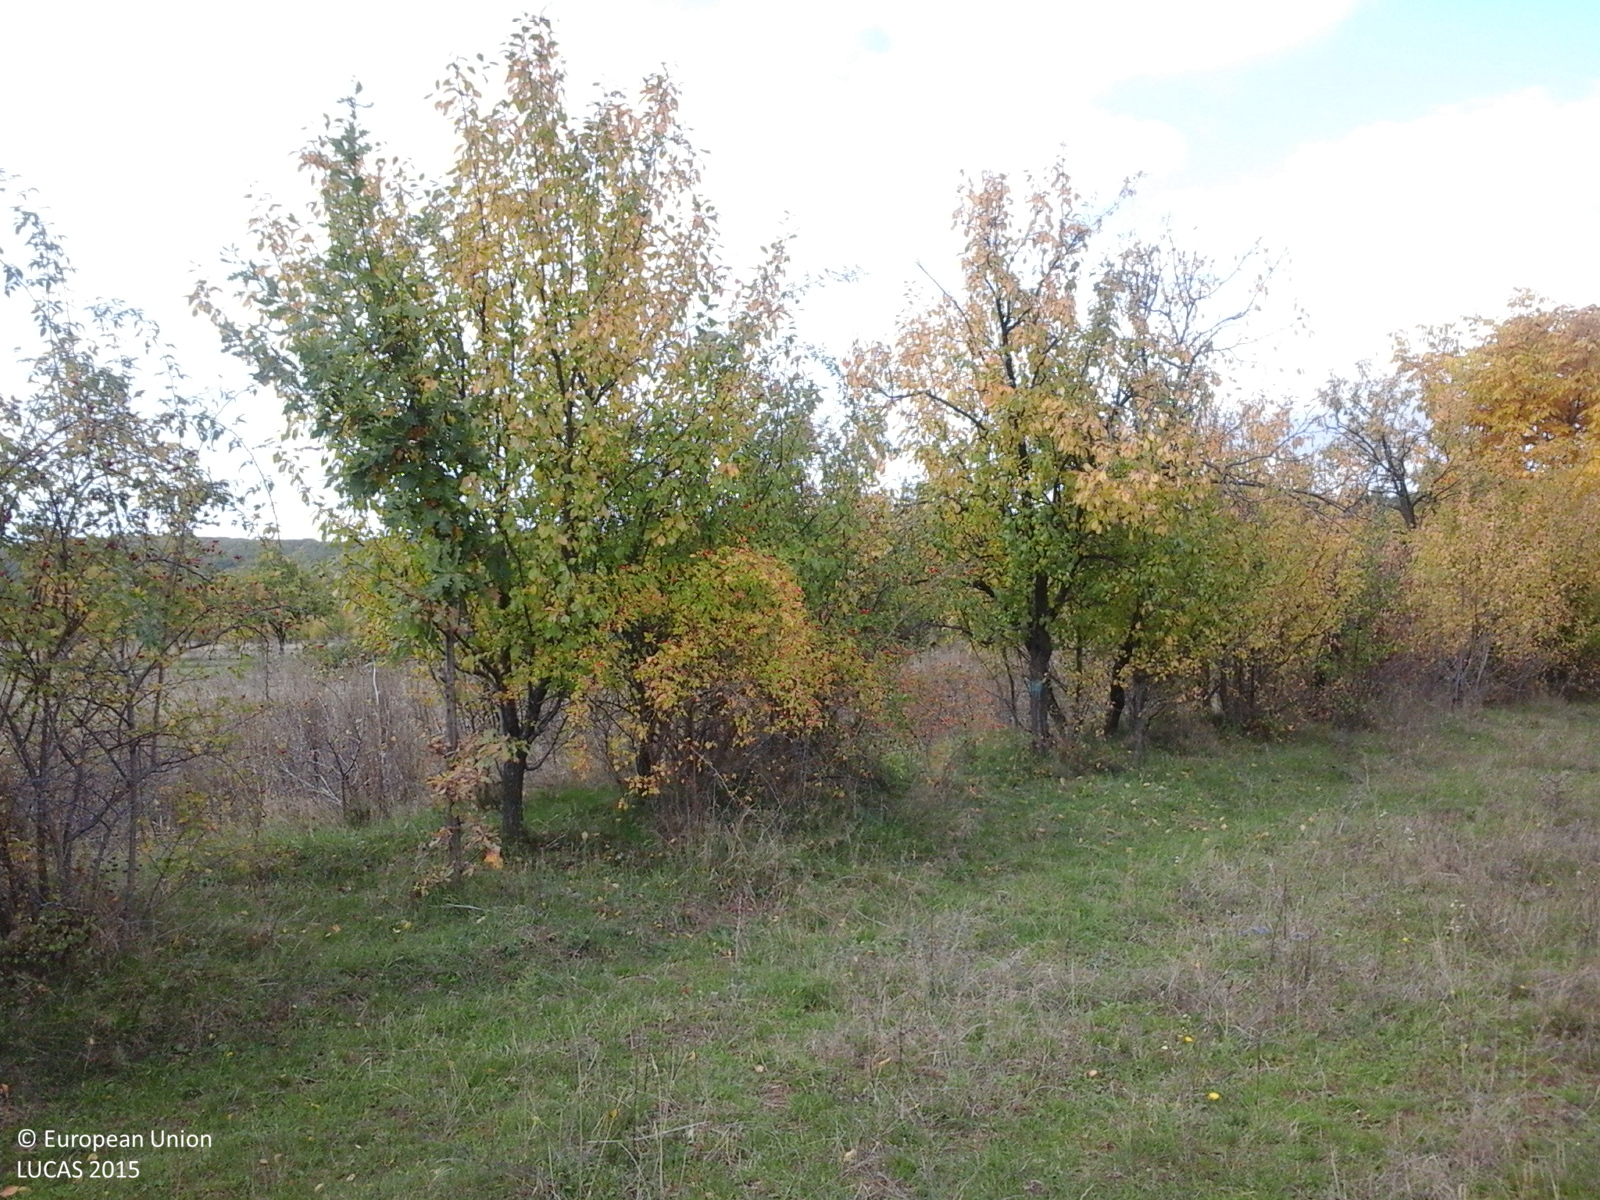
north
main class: Grassland
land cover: Grassland without tree/shrub cover
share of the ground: > 75 %
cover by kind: herbaceous plants 100 %
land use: Agriculture (excluding fallow land and kitchen gardens)
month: October
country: RO
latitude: 45.0946
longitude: 25.7971
